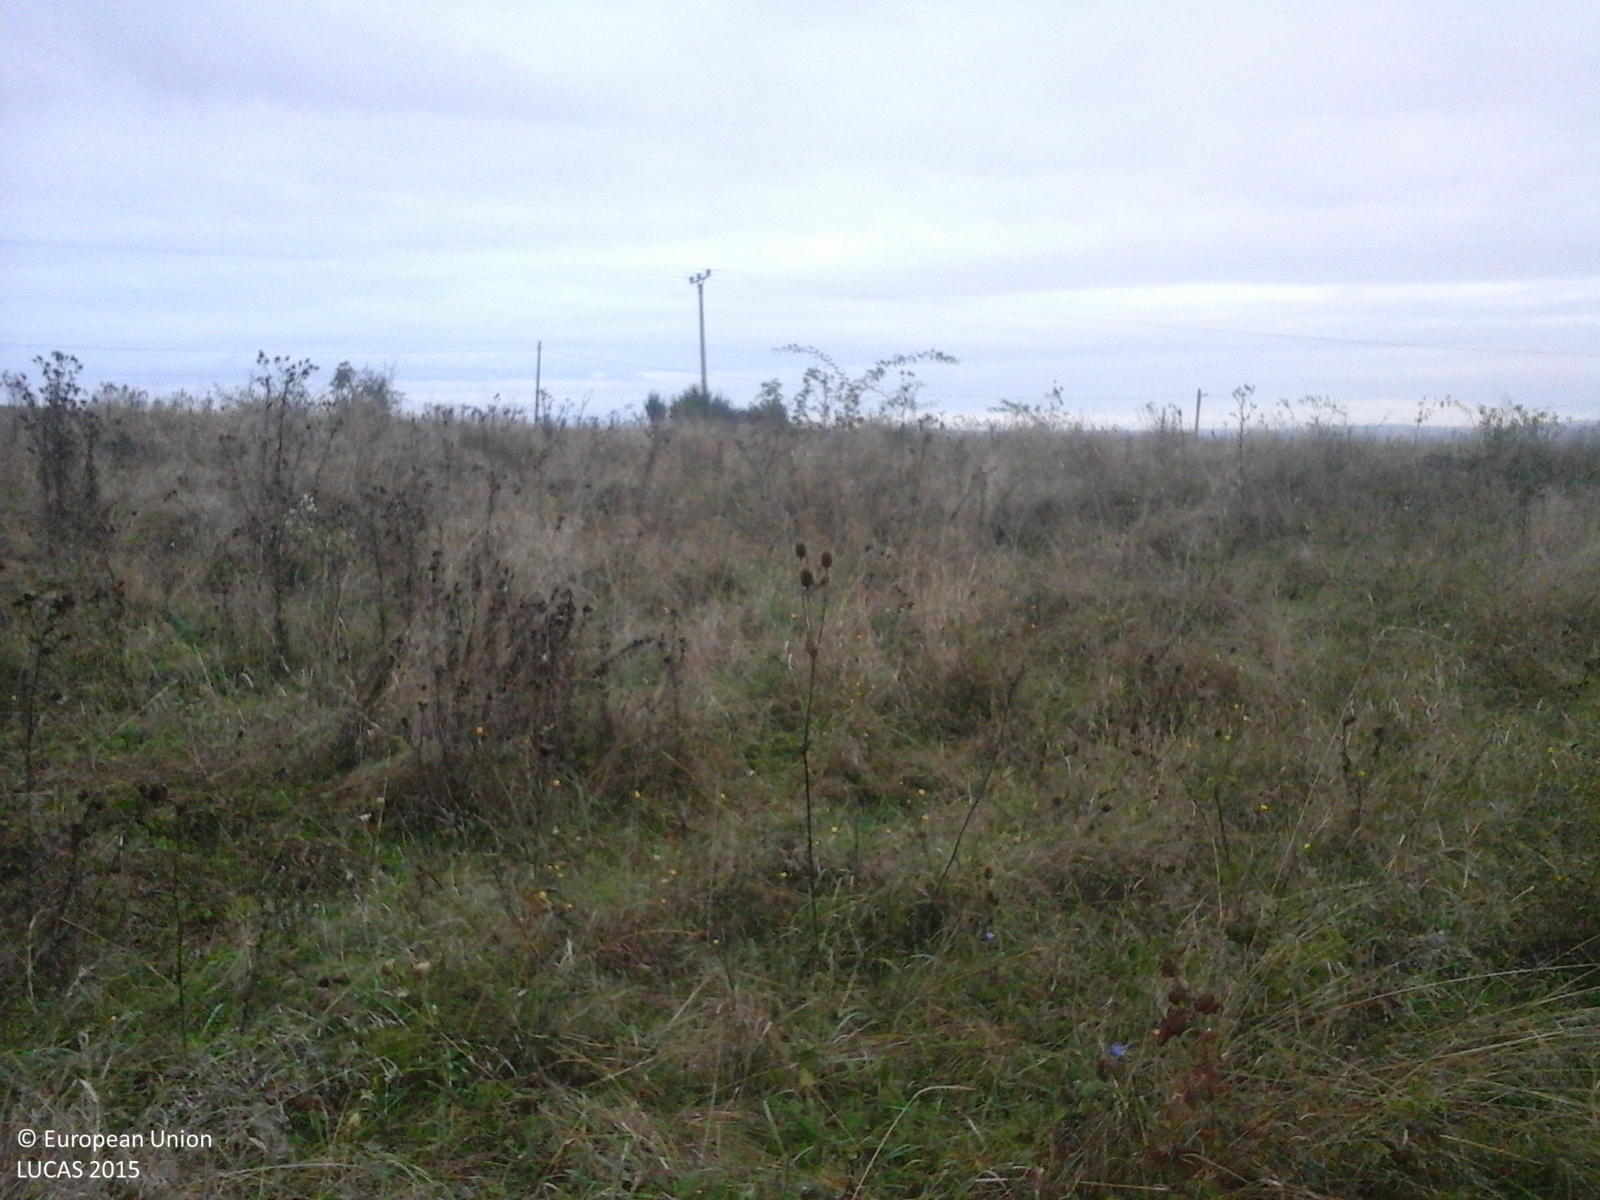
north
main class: Grassland
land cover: Grassland with sparse tree/shrub cover
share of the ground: > 75 %
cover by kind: herbaceous plants 85 %, shrubs 10 %, broadleaved forest trees 5 %
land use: Fallow land
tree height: < 5 m
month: September
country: RO
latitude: 45.8520
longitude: 23.8099
